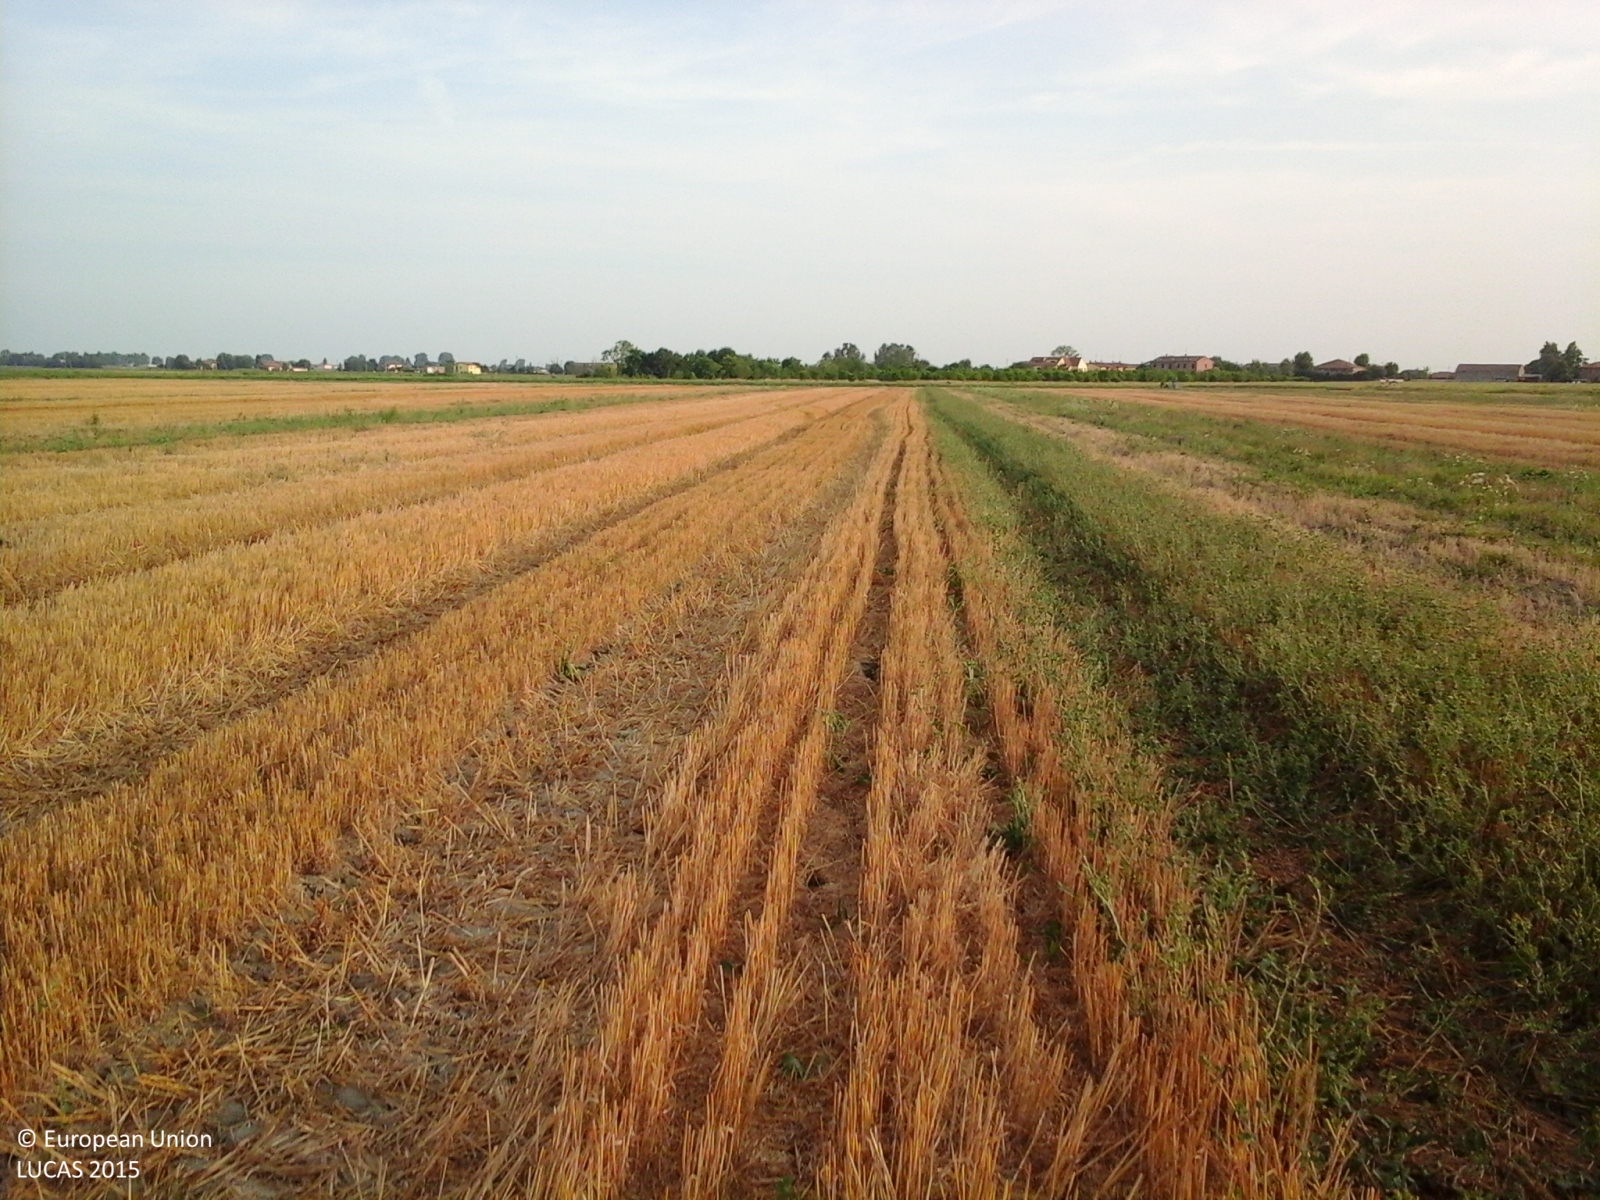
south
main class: Cropland
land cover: Common wheat
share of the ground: > 75 %
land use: Agriculture (excluding fallow land and kitchen gardens)
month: July
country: IT
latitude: 44.8071
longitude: 11.6025
